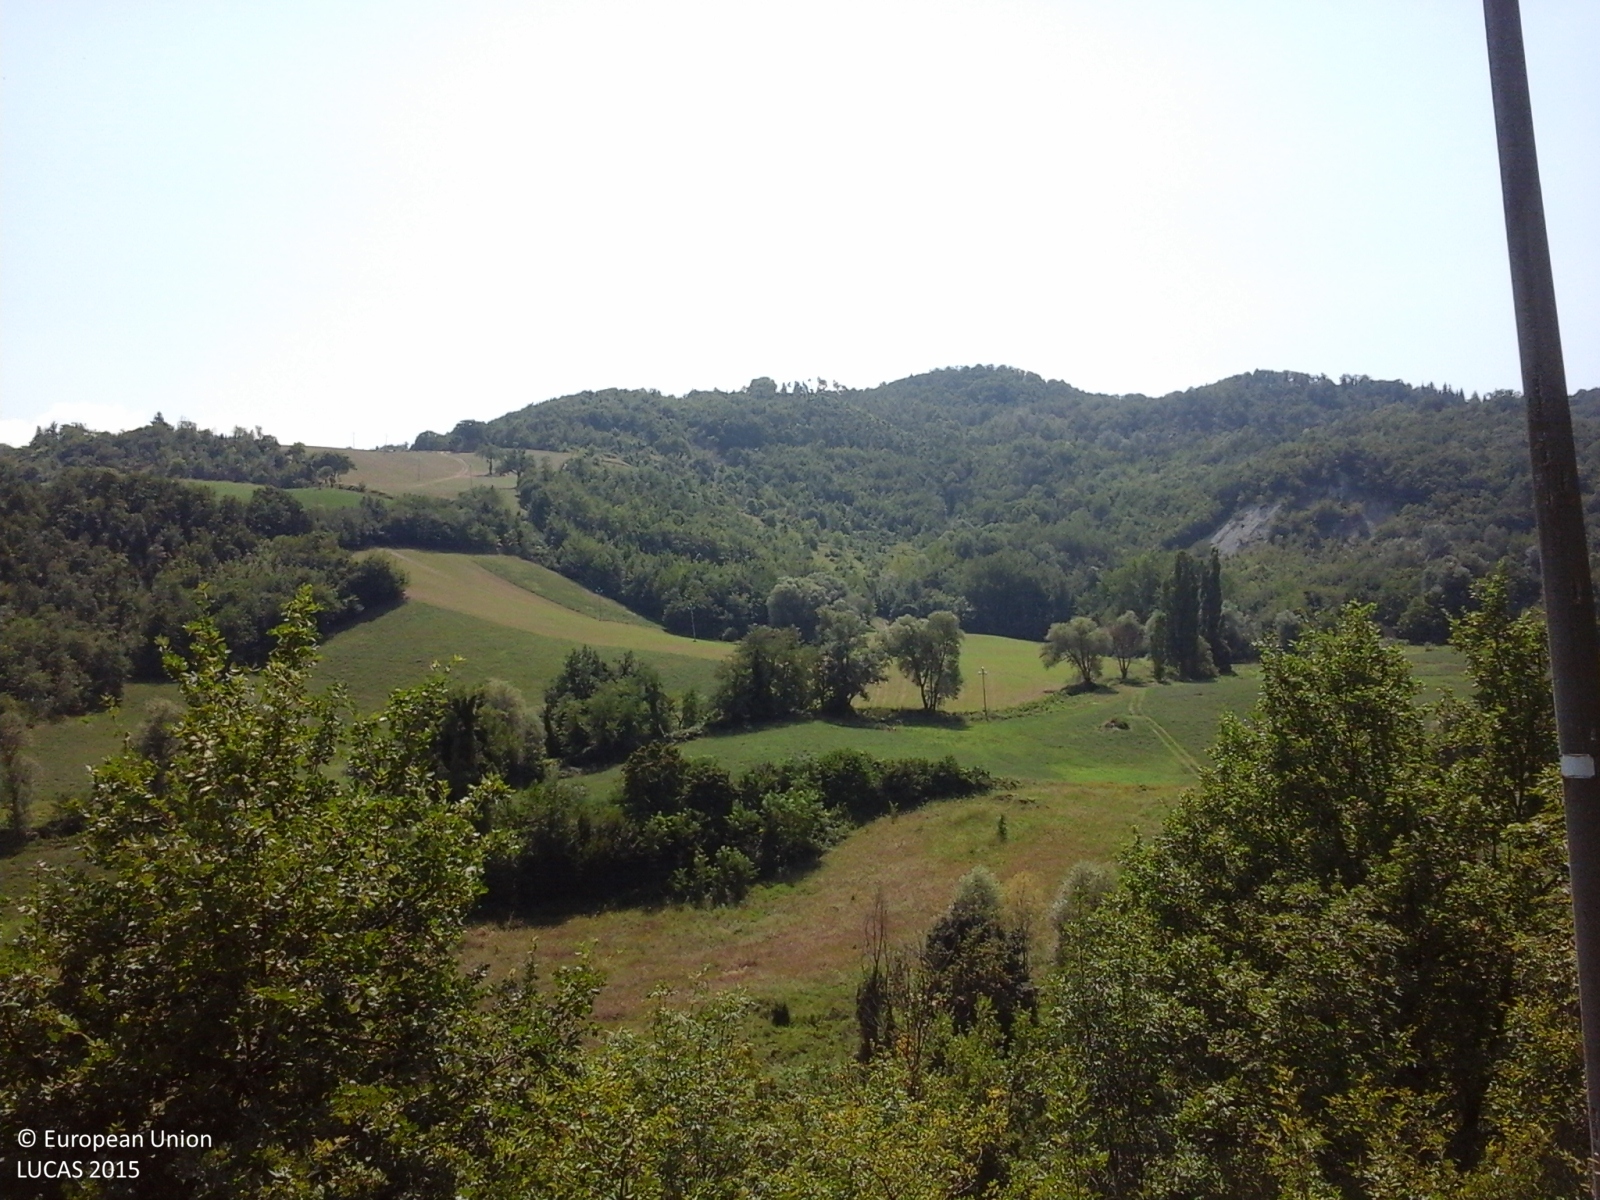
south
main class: Woodland
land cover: Broadleaved woodland
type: mesophytic deciduous forest
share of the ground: > 75 %
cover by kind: broadleaved forest trees 100 %
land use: Forestry
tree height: > 5 m
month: August
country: IT
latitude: 43.0757
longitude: 13.1232
